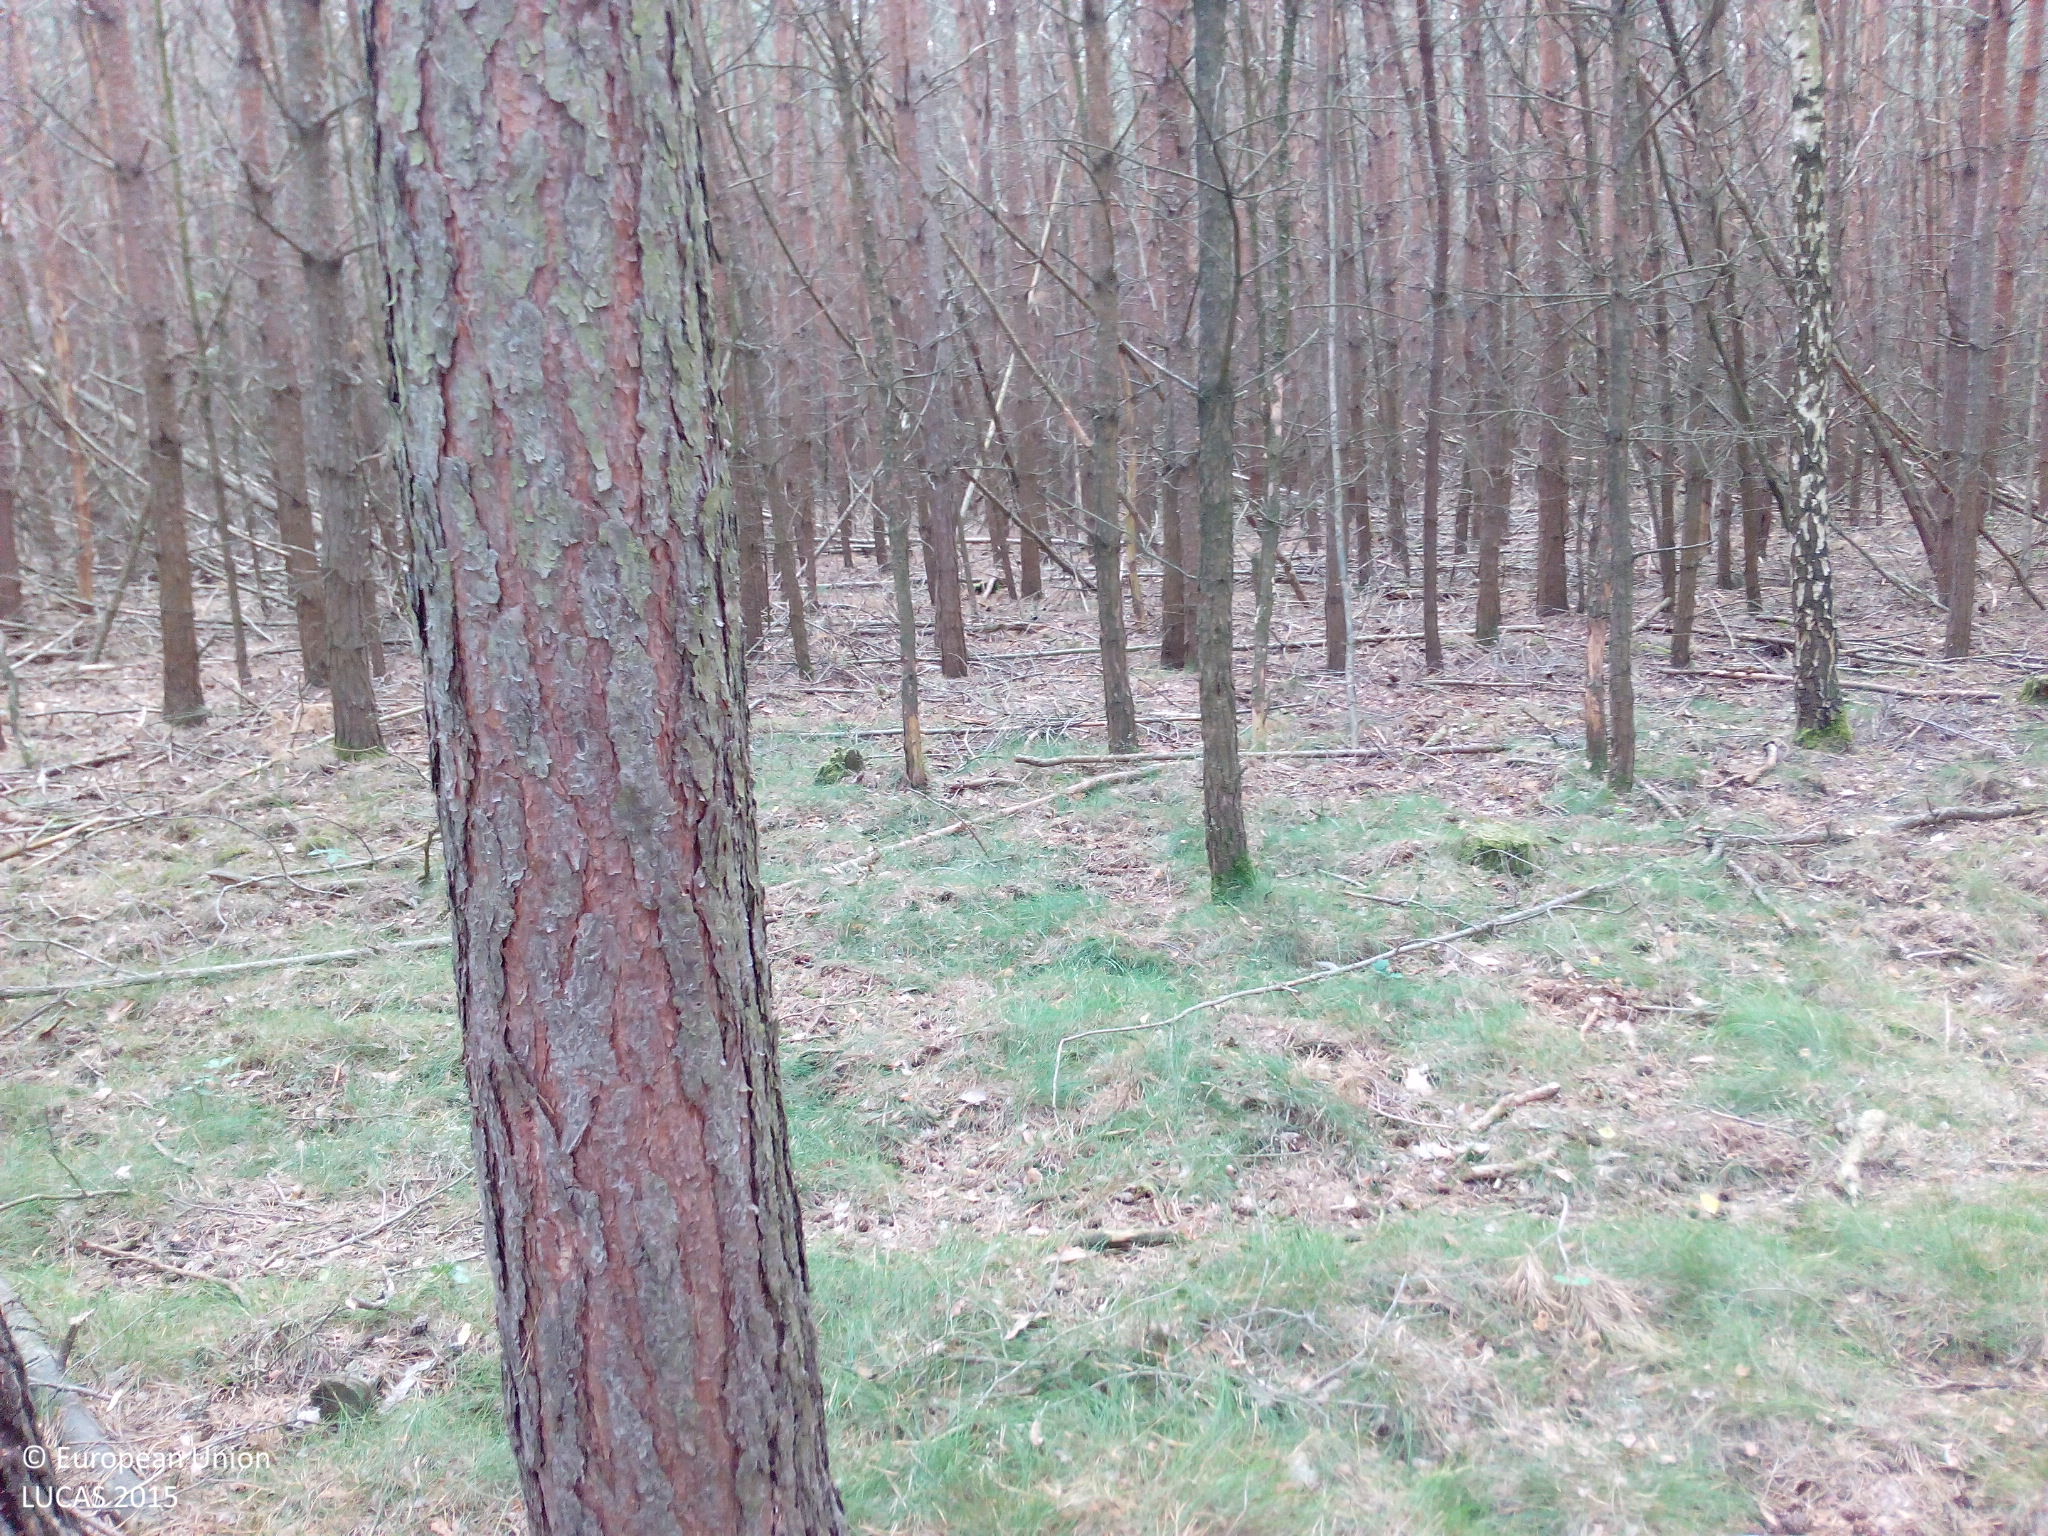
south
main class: Woodland
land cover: Pine dominated coniferous woodland
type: hemiboreal forest and nemoral coniferous forest and mixed broadleaved-coniferous forest
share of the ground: > 75 %
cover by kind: coniferous forest trees 90 %, herbaceous plants 10 %
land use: Forestry
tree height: > 5 m
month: June
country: DE
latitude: 52.1570
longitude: 12.3237
